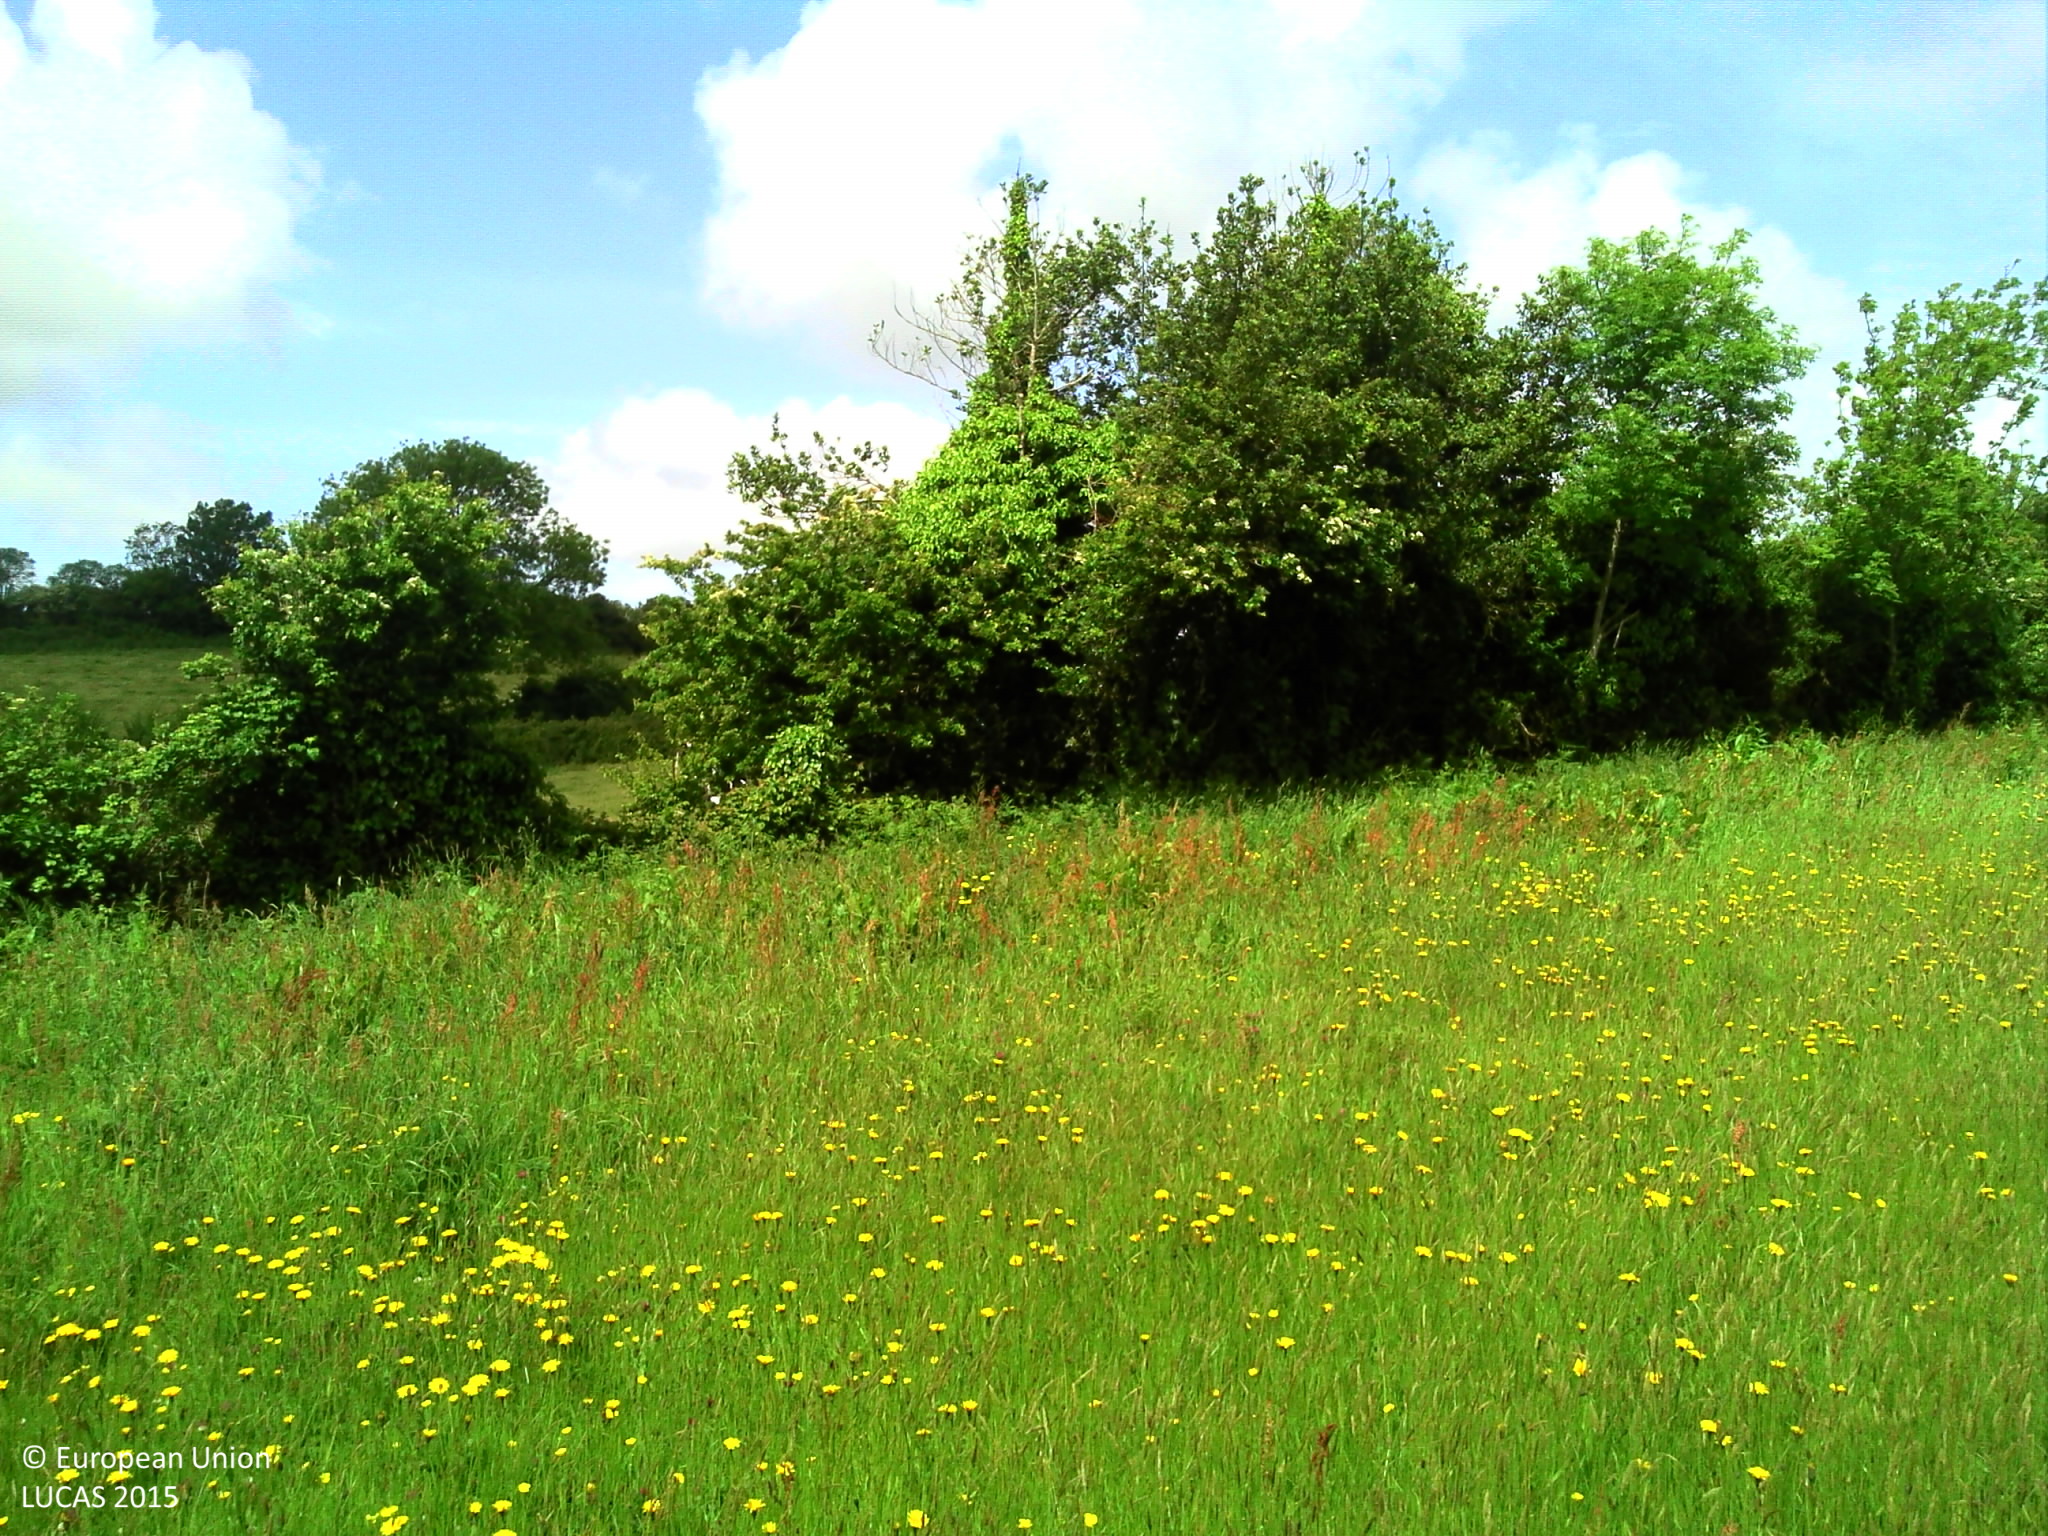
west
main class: Grassland
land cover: Grassland without tree/shrub cover
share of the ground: > 75 %
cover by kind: herbaceous plants 100 %
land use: Agriculture (excluding fallow land and kitchen gardens)
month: June
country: FR
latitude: 49.6640
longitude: -1.7604
